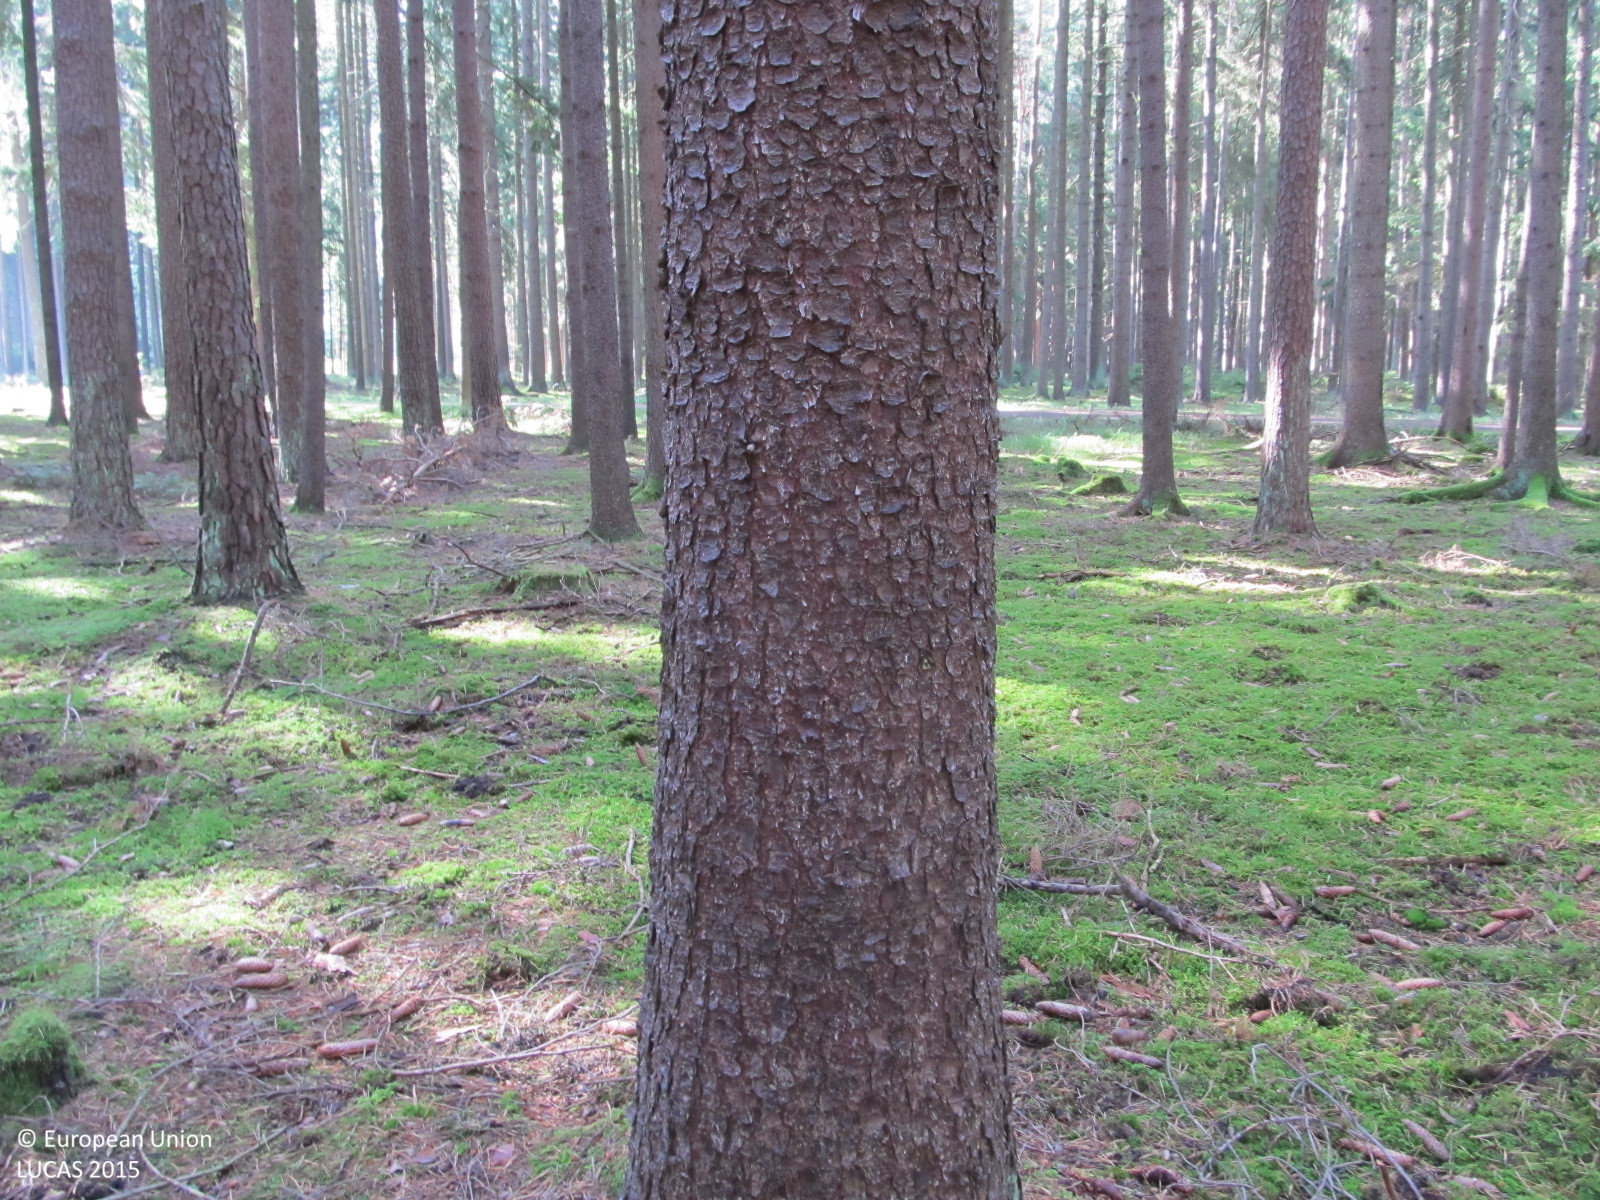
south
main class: Woodland
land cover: Spruce dominated coniferous woodland
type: hemiboreal forest and nemoral coniferous forest and mixed broadleaved-coniferous forest
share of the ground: > 75 %
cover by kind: coniferous forest trees 80 %, lichens and mosses 15 %, unconsolidated bare surface 5 %
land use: Forestry
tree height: > 5 m
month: September
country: AT
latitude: 48.7390
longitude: 15.4284
